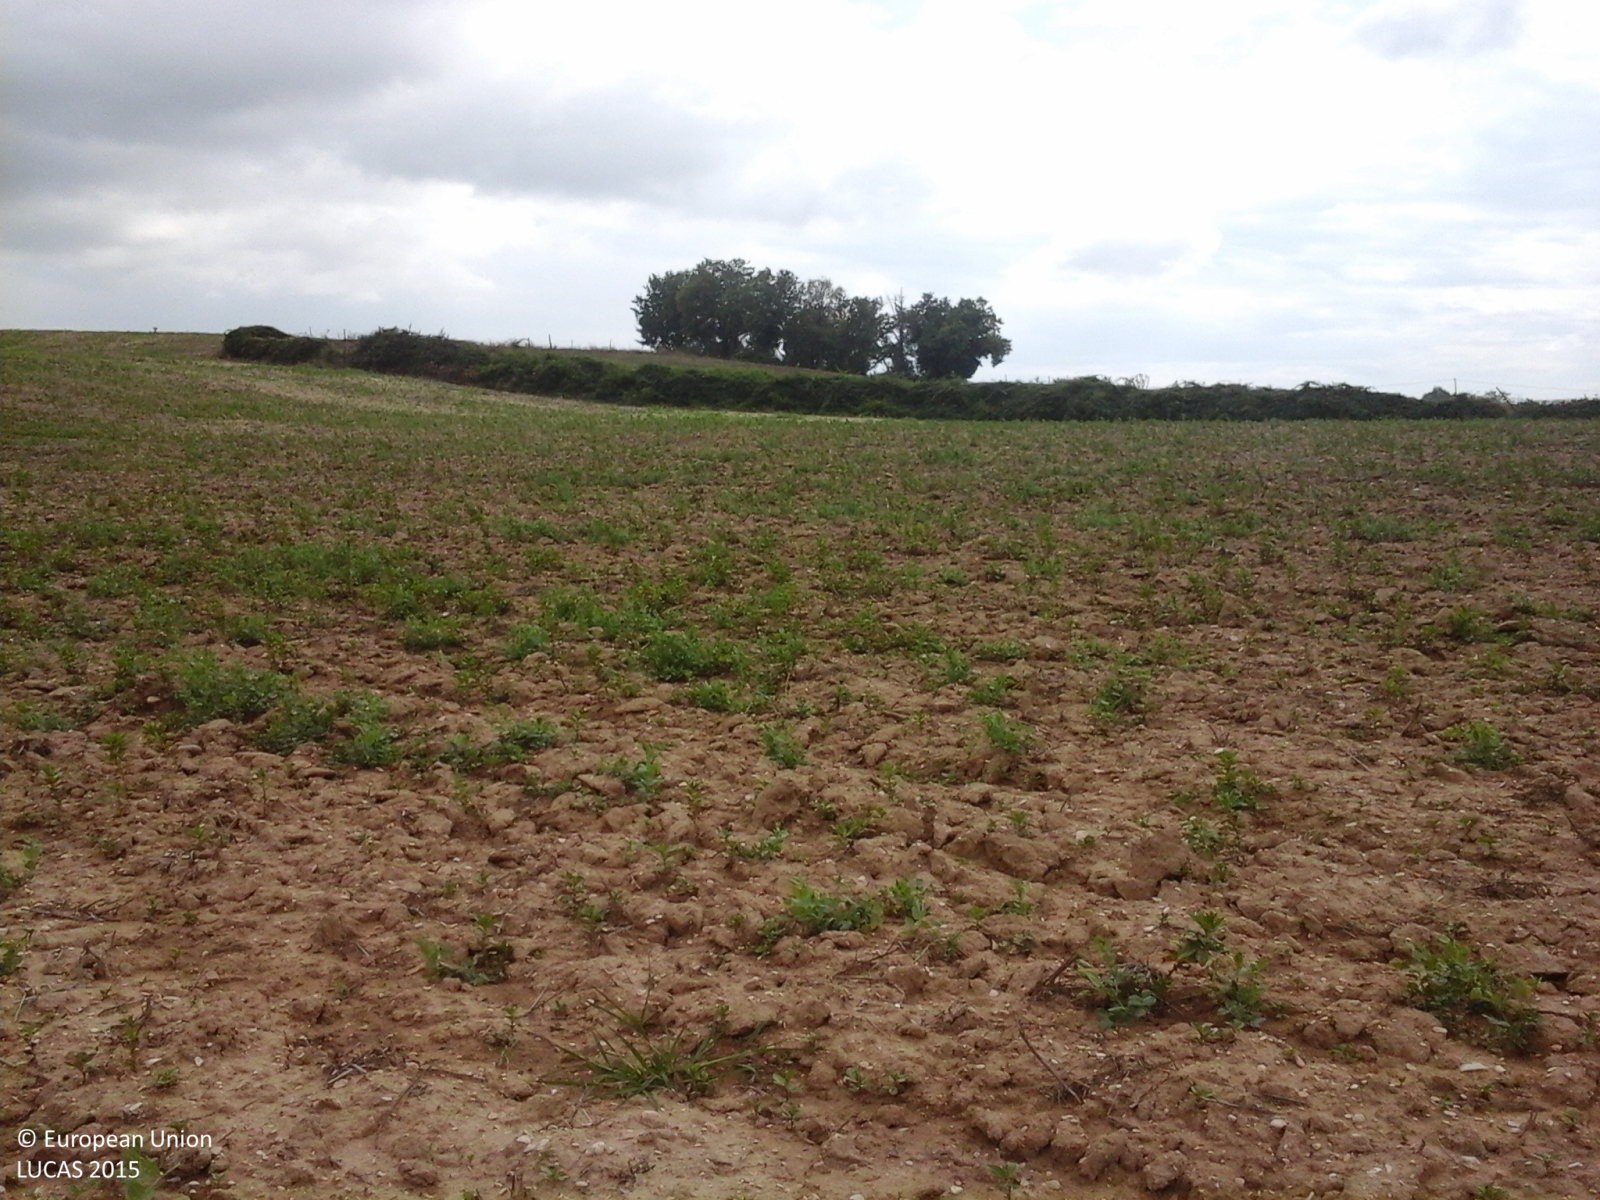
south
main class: Cropland
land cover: Dry pulses
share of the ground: < 10 %
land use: Agriculture (excluding fallow land and kitchen gardens)
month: August
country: IT
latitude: 43.4505
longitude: 13.2665
